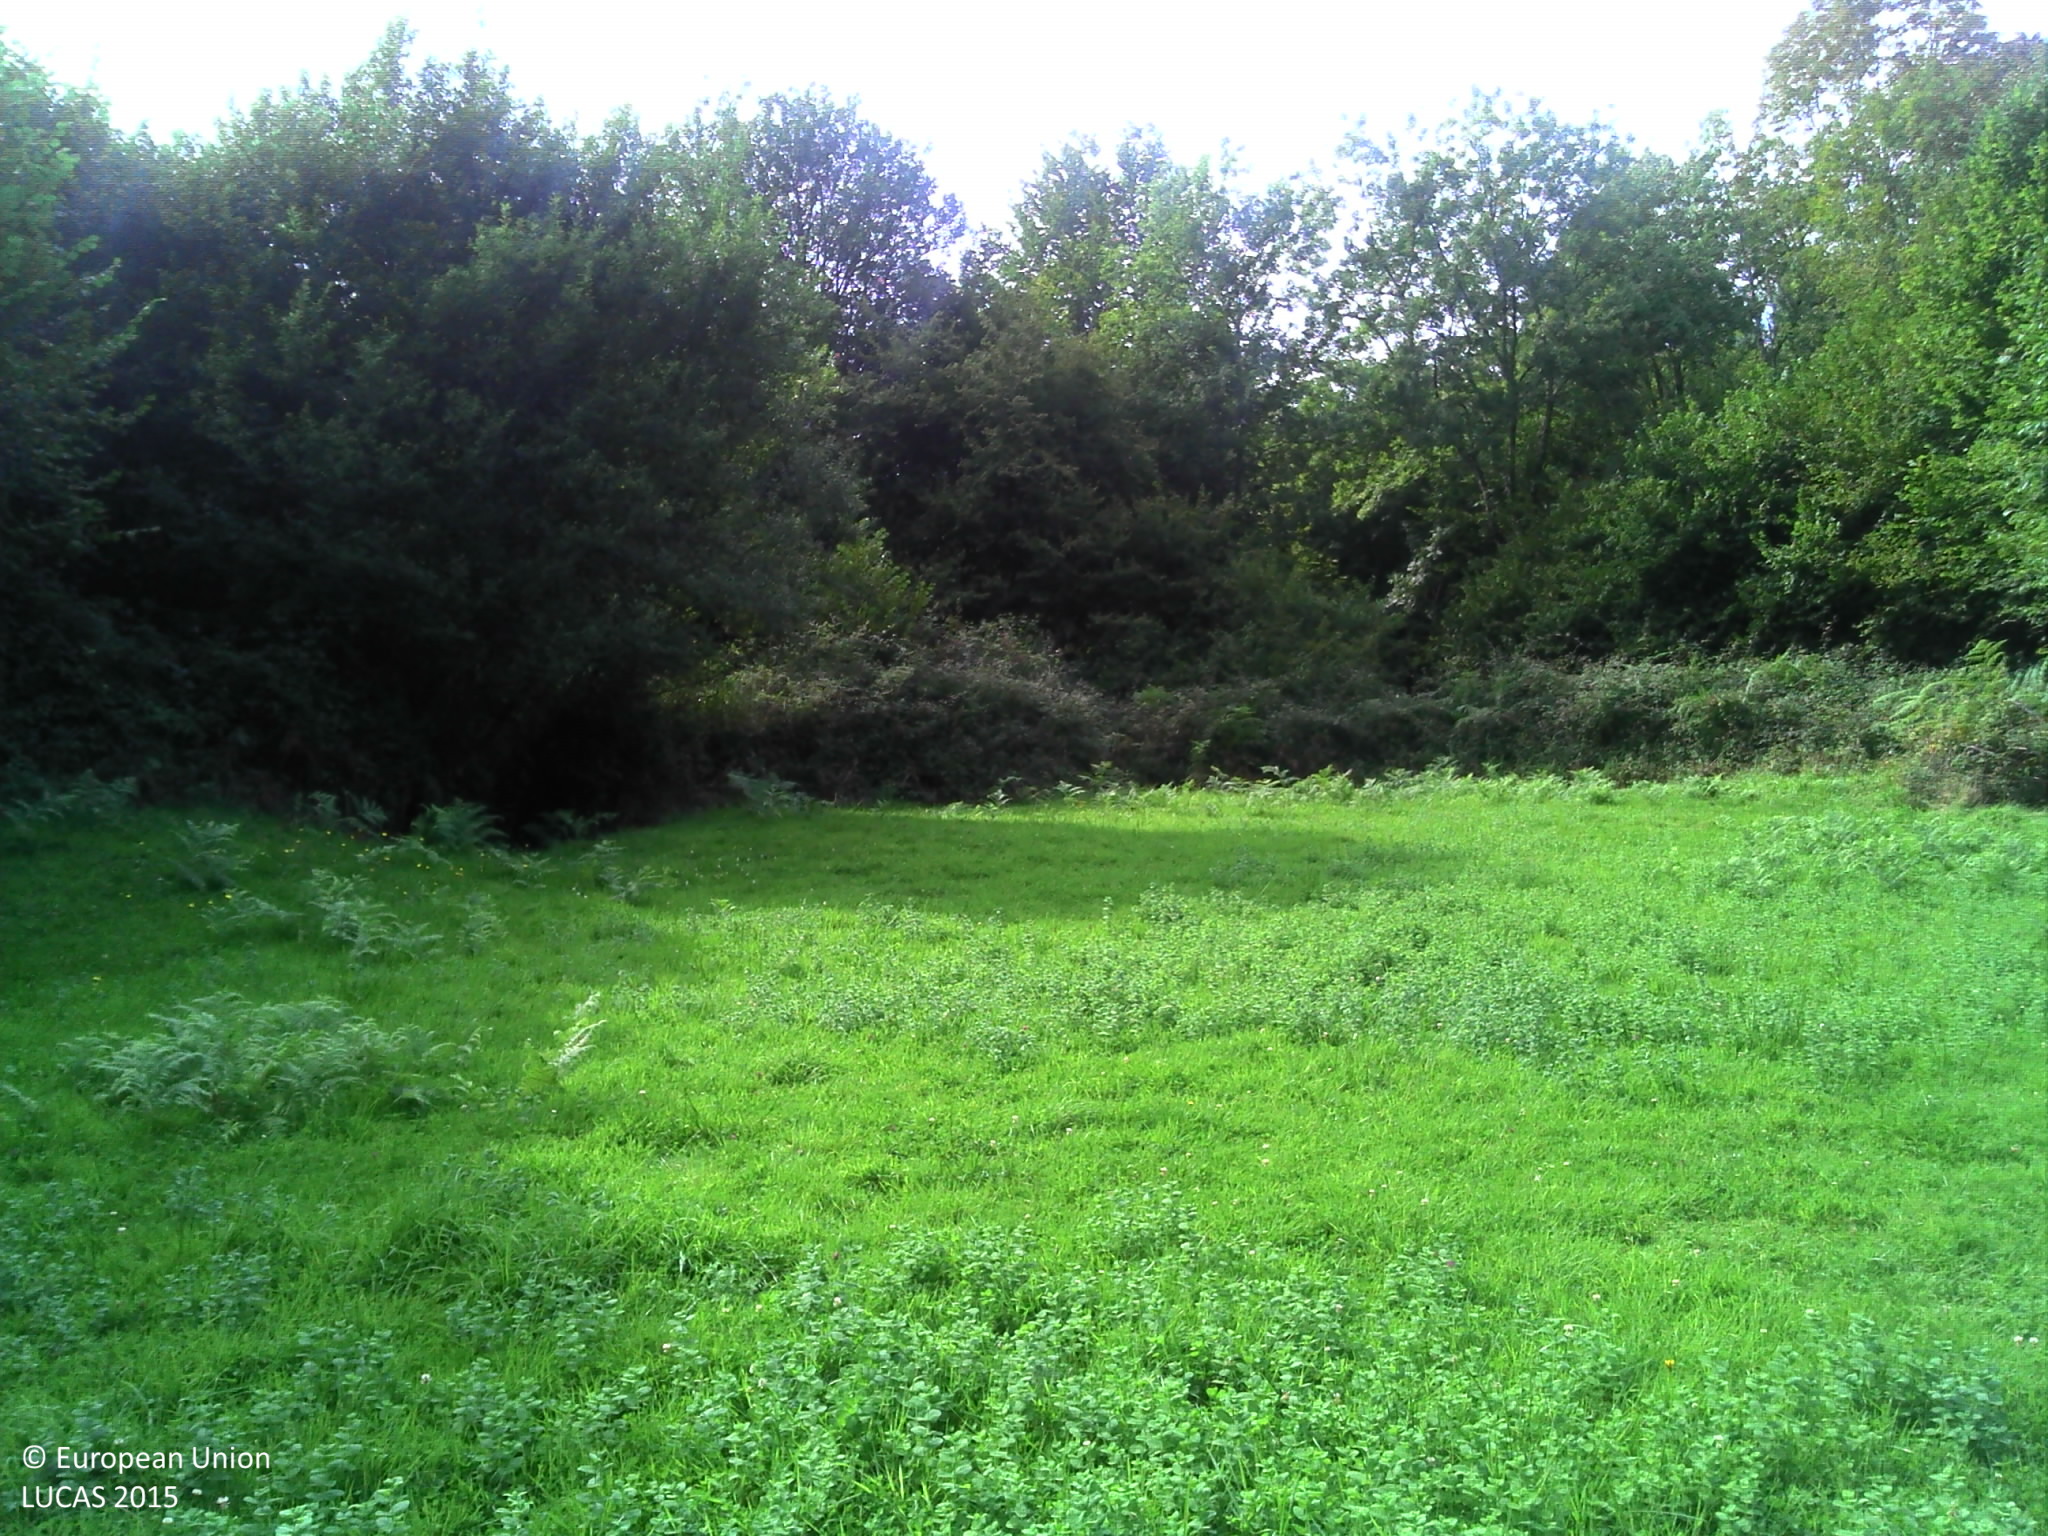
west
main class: Grassland
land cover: Grassland without tree/shrub cover
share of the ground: > 75 %
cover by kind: herbaceous plants 100 %
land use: Agriculture (excluding fallow land and kitchen gardens)
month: September
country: FR
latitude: 43.1615
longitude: -1.0189
